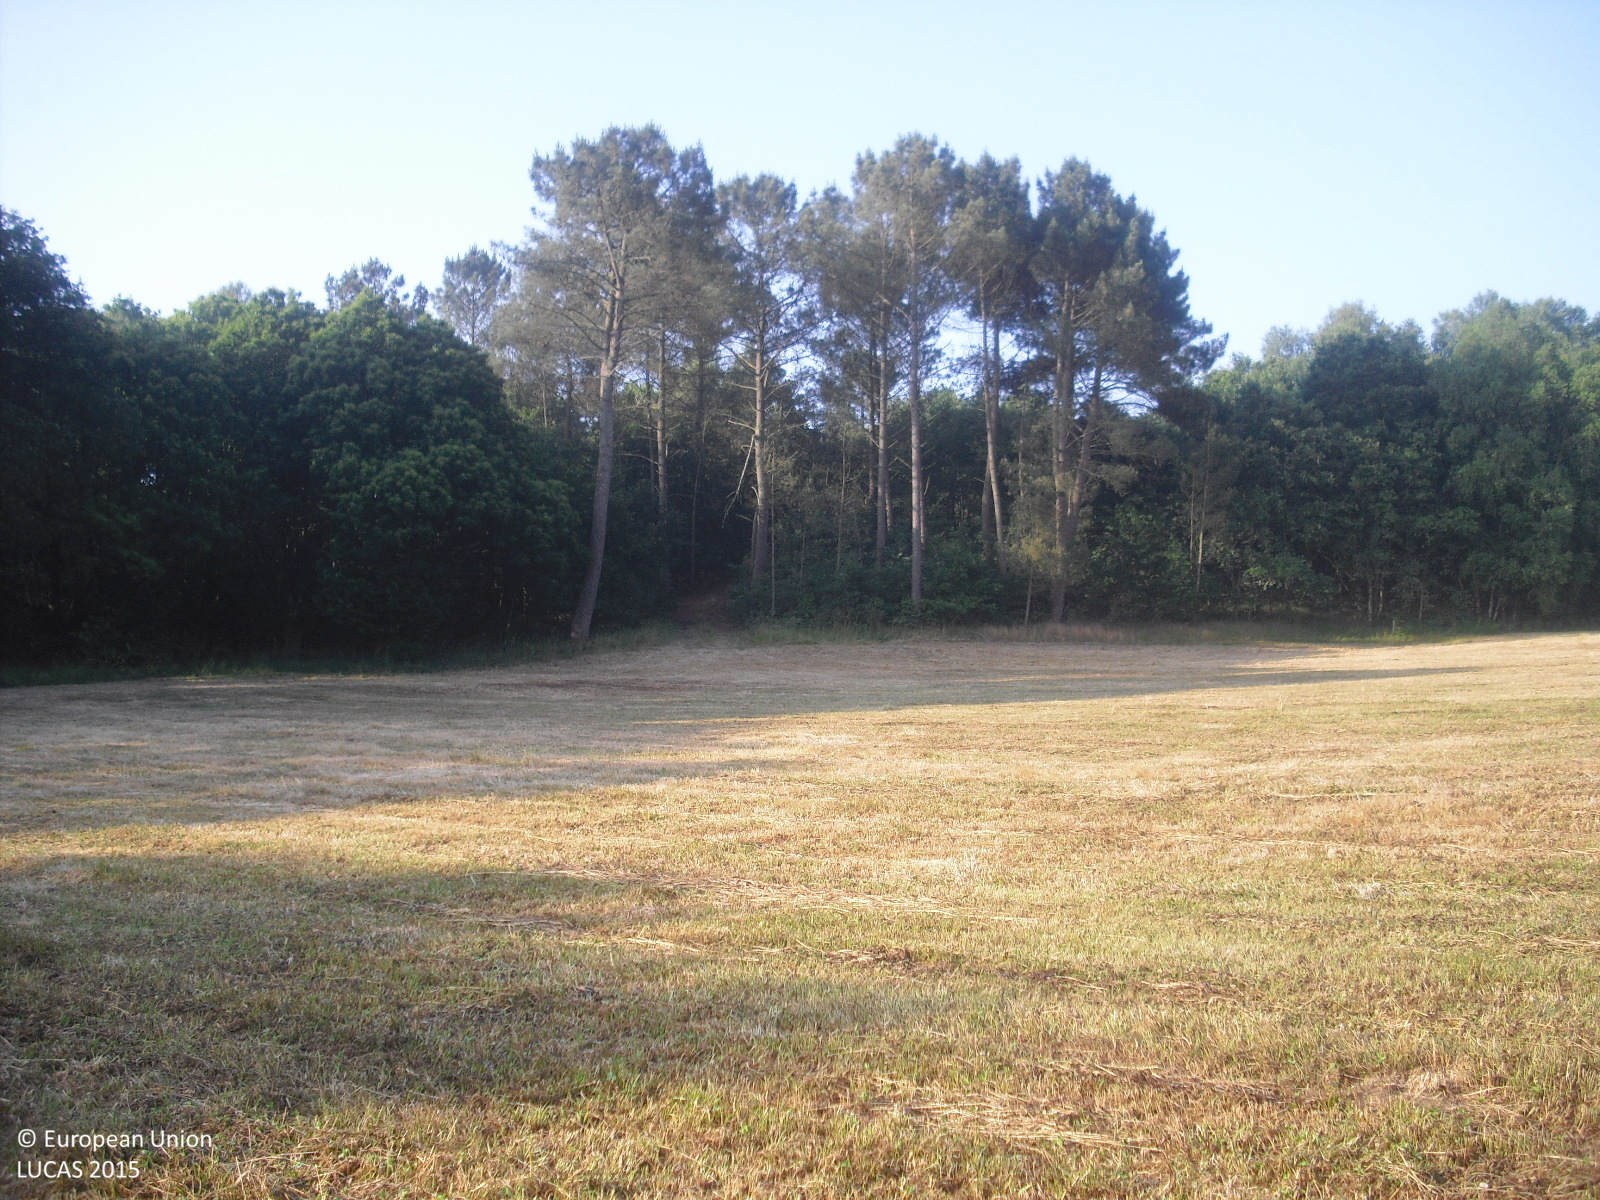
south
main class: Cropland
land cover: Temporary grasslands
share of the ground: > 75 %
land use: Agriculture (excluding fallow land and kitchen gardens)
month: June
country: ES
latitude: 42.5391
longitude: -7.7941
